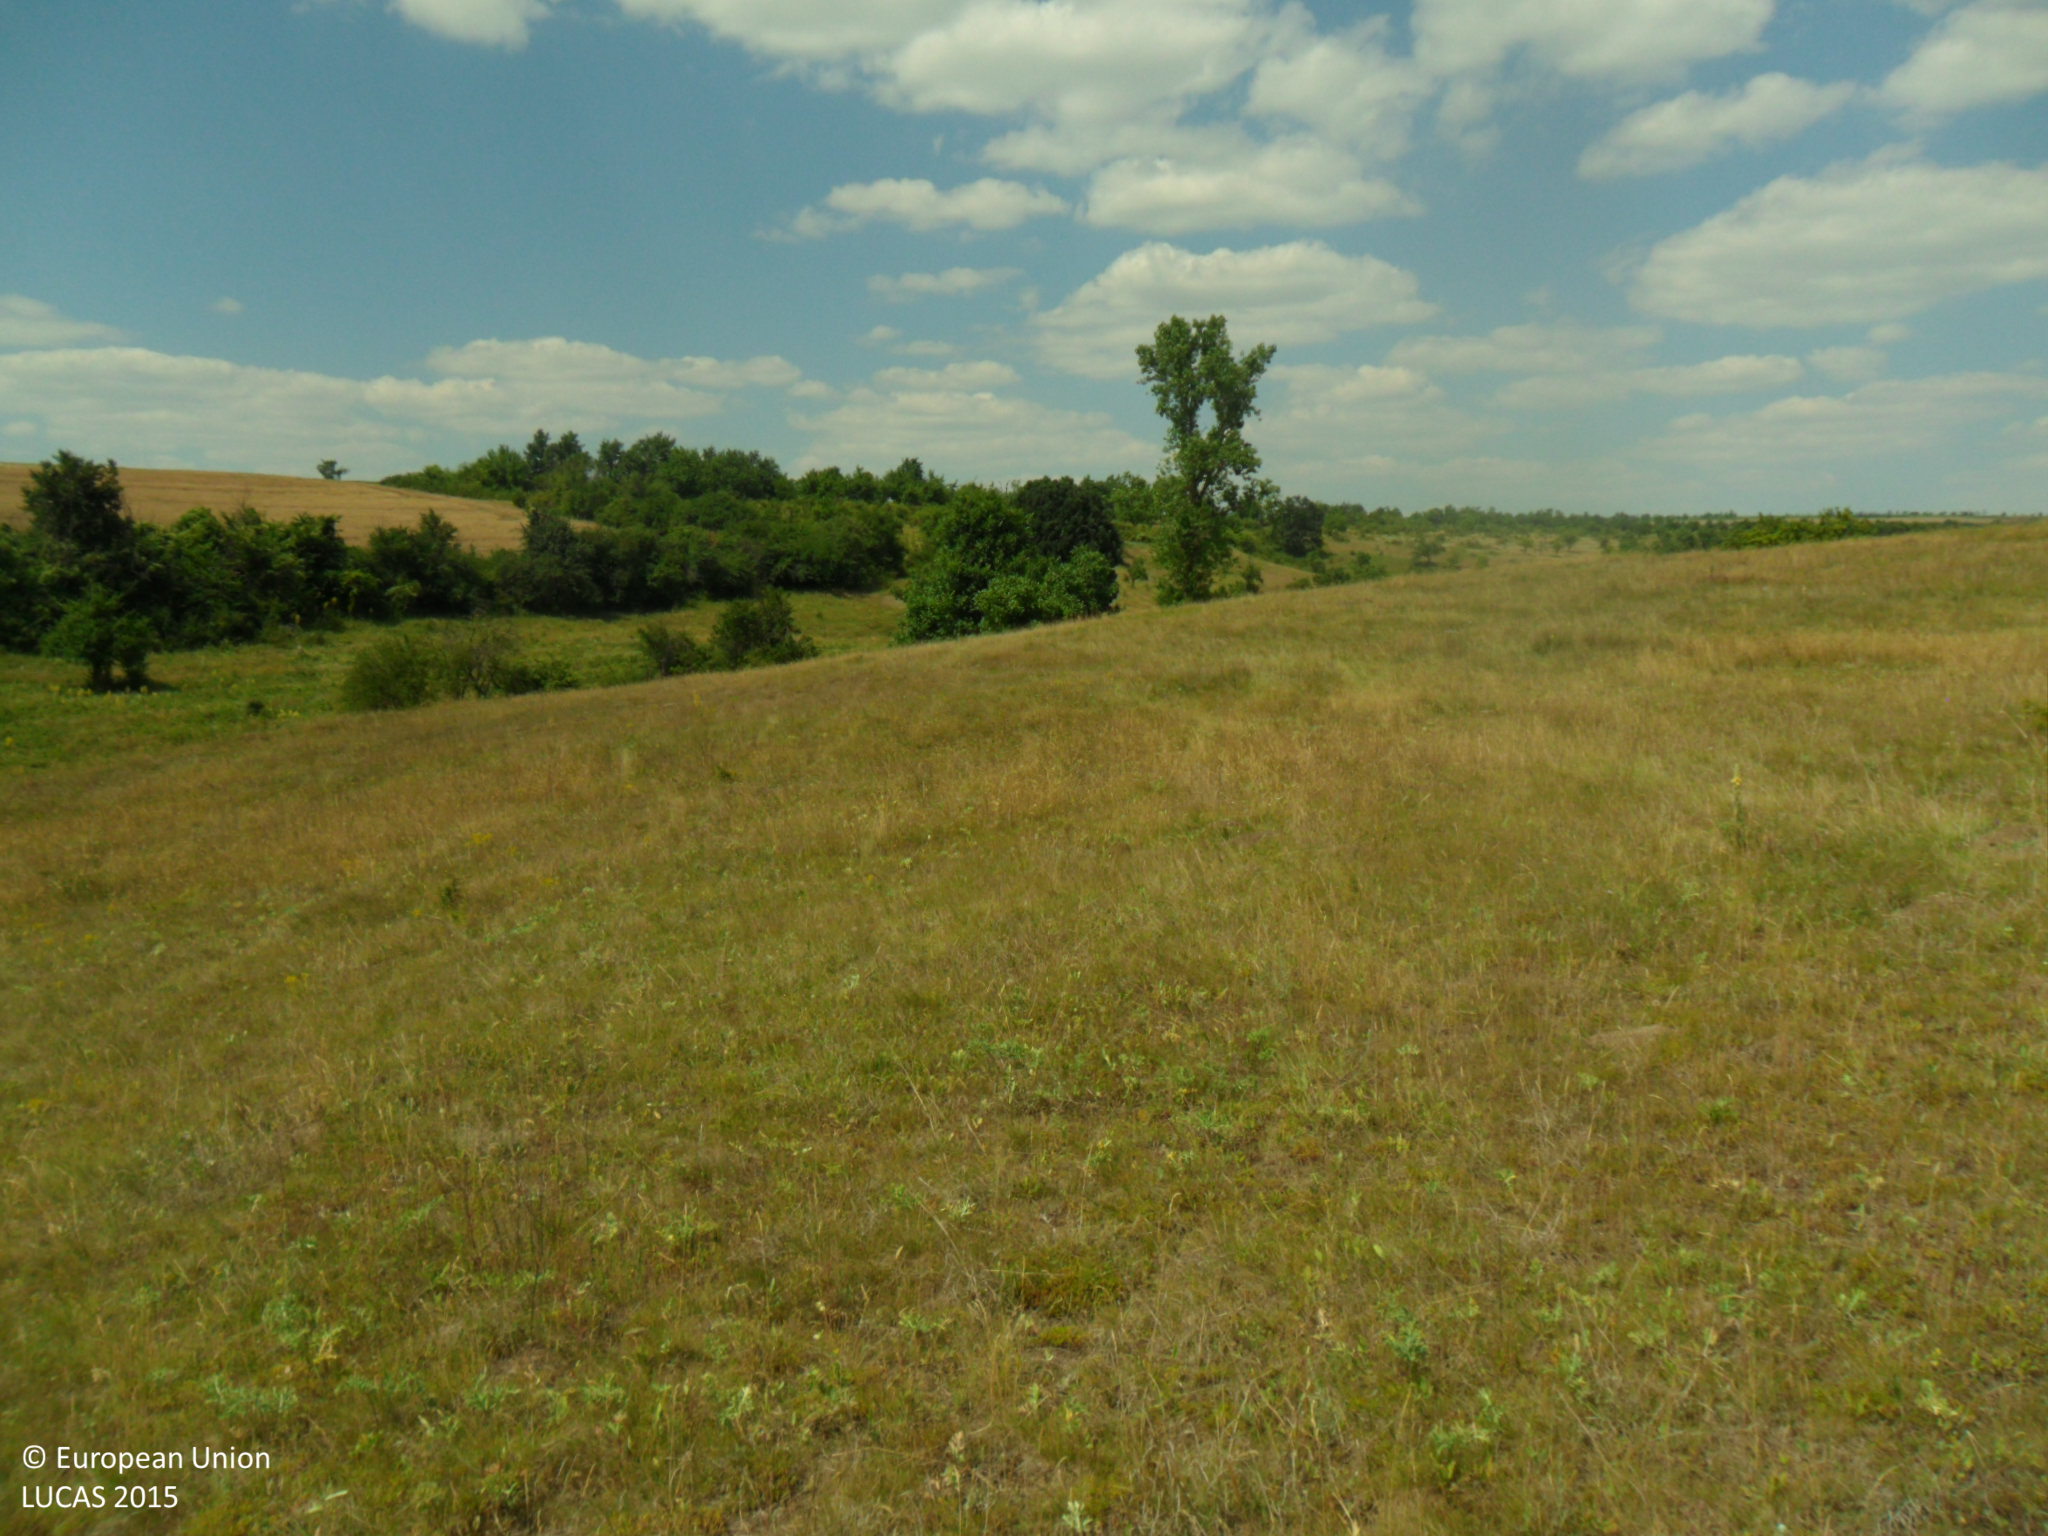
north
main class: Grassland
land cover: Grassland without tree/shrub cover
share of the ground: > 75 %
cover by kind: herbaceous plants 100 %
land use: Agriculture (excluding fallow land and kitchen gardens)
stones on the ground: < 10 %
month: June
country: BG
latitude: 43.4611
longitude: 26.9366
